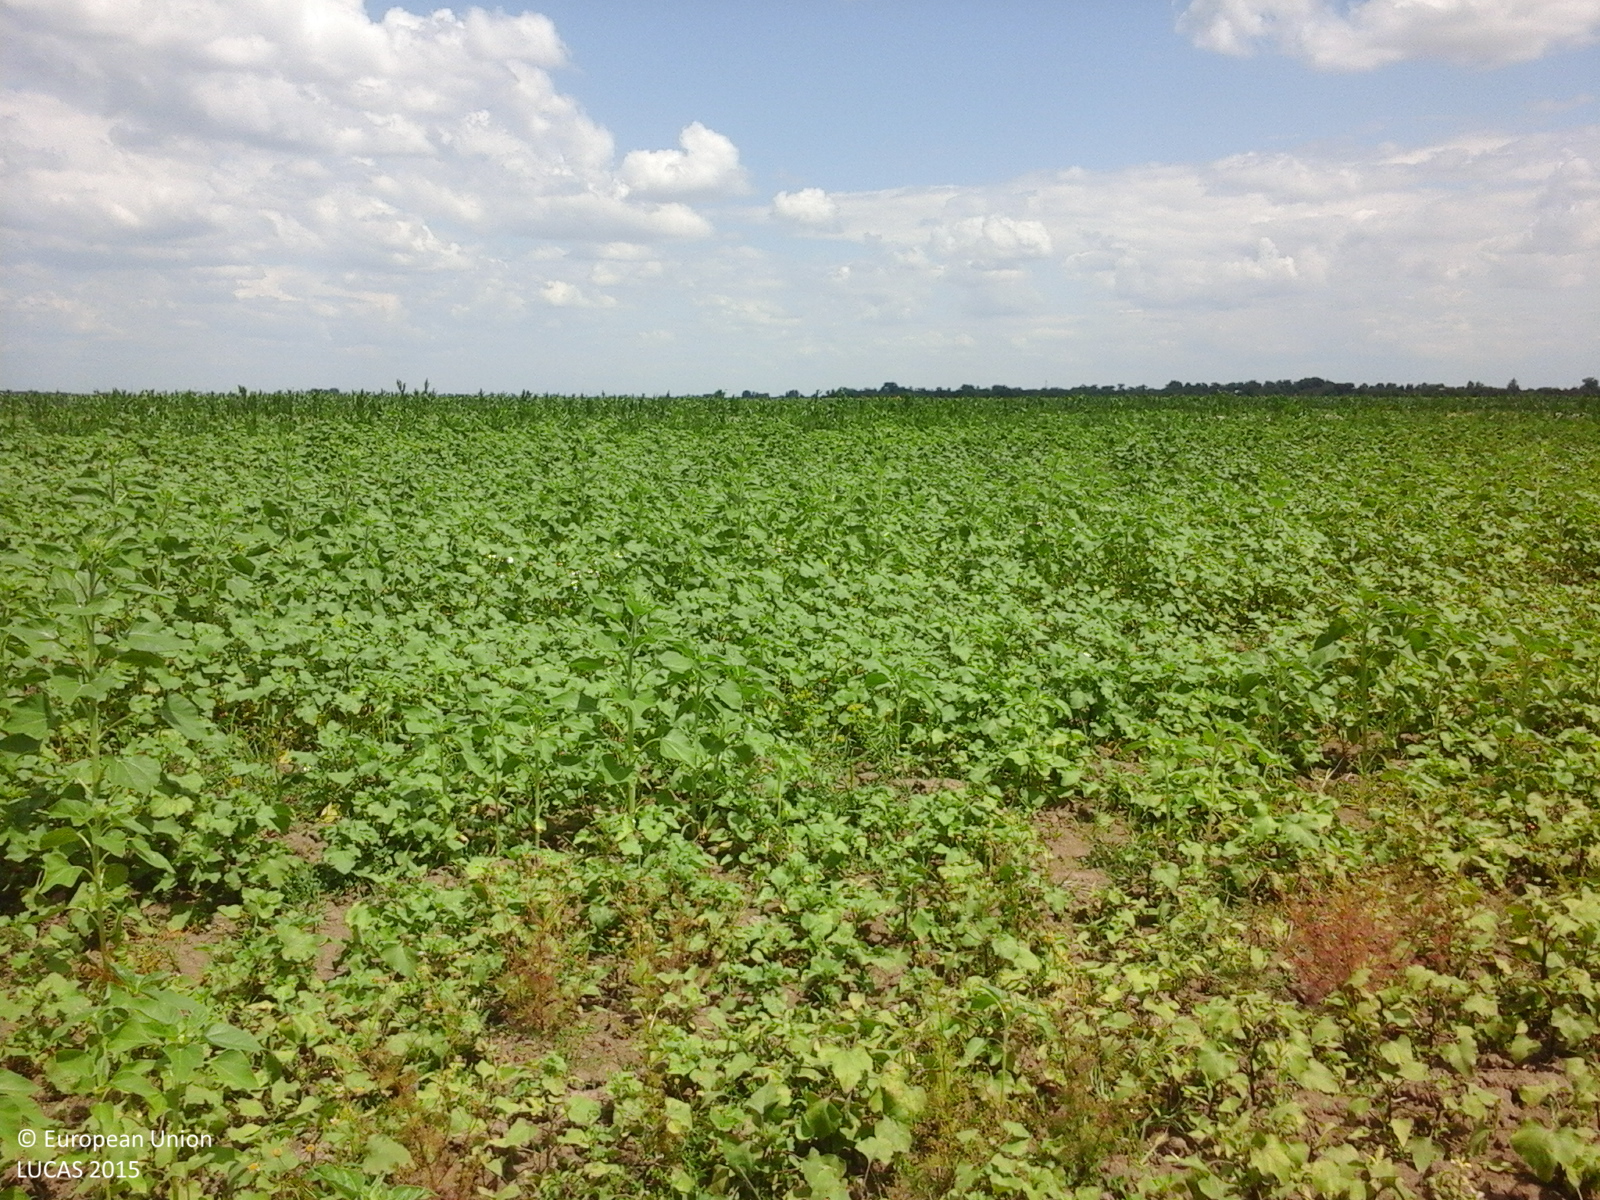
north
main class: Cropland
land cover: Sunflower
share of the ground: > 75 %
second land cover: Spontaneously vegetated surfaces
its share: > 75 %
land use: Agriculture (excluding fallow land and kitchen gardens)
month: July
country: RO
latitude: 44.2738
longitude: 25.2821
